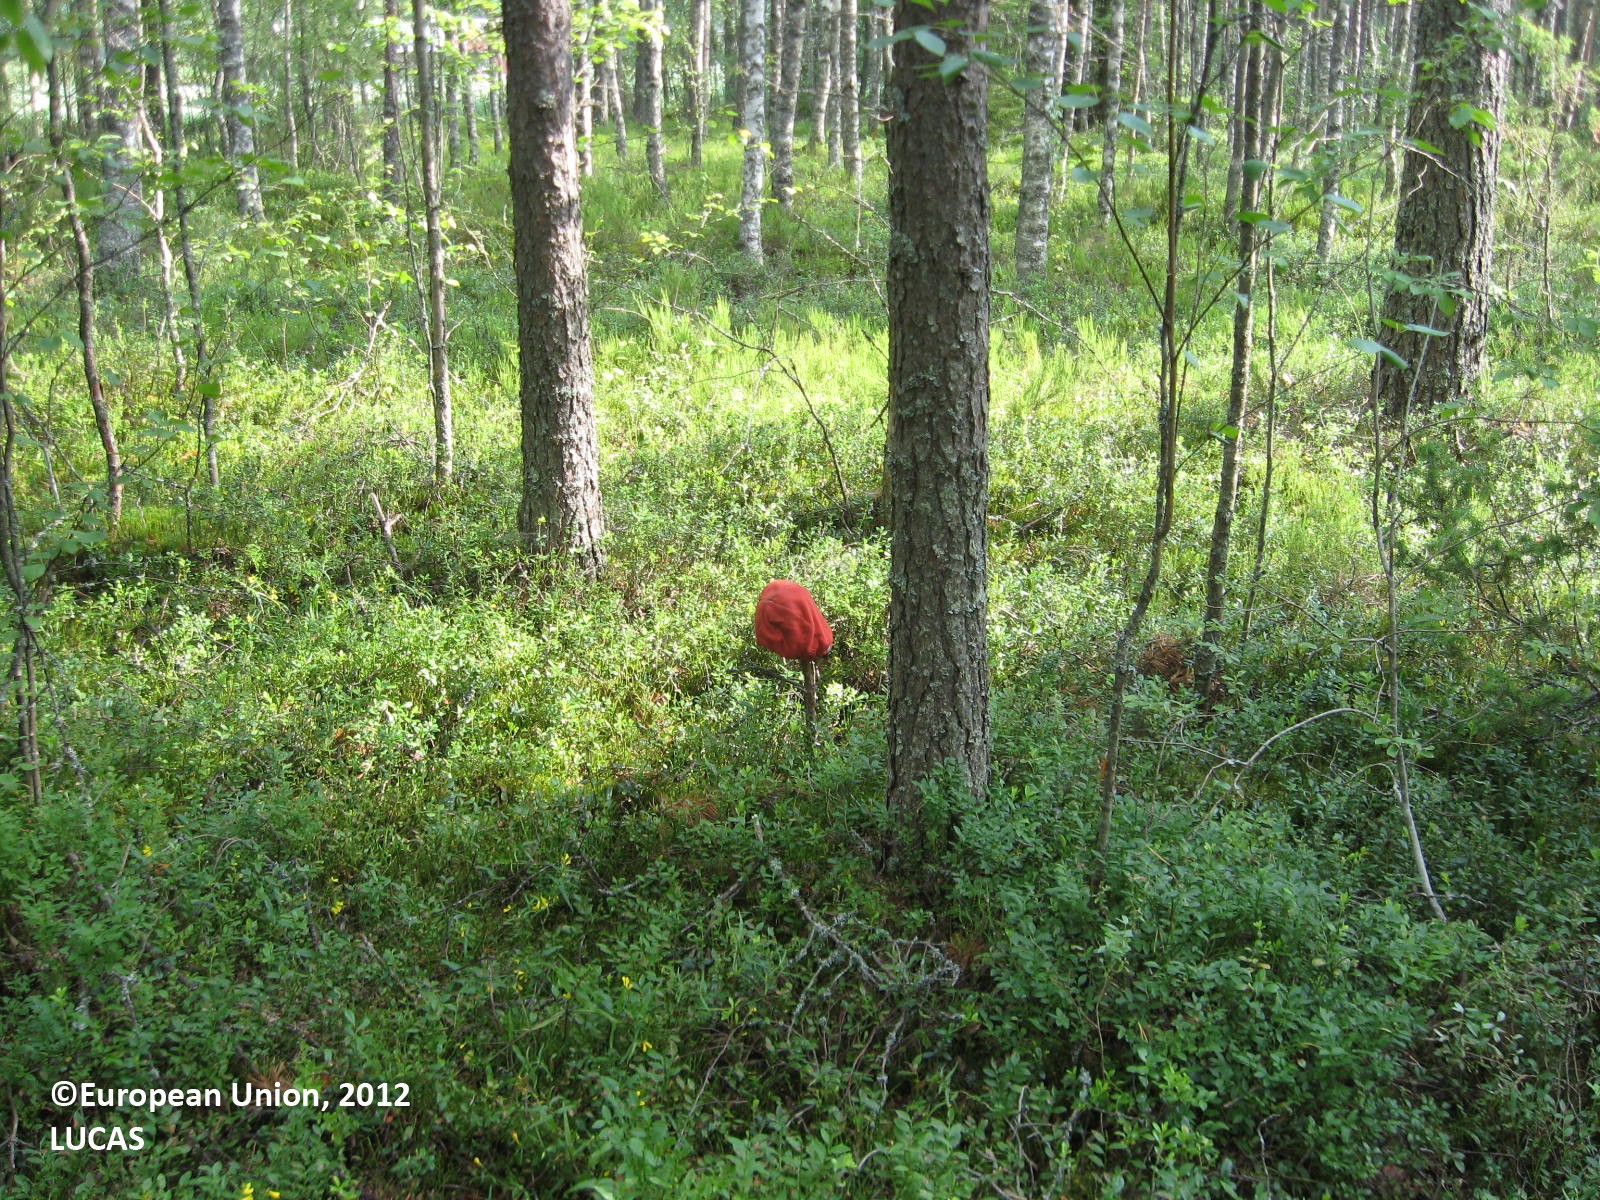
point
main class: Woodland
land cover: Pine dominated mixed woodland
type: boreal forest
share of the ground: > 75 %
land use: Forestry
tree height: > 5 m
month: July
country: FI
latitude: 61.8987
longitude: 22.3715
